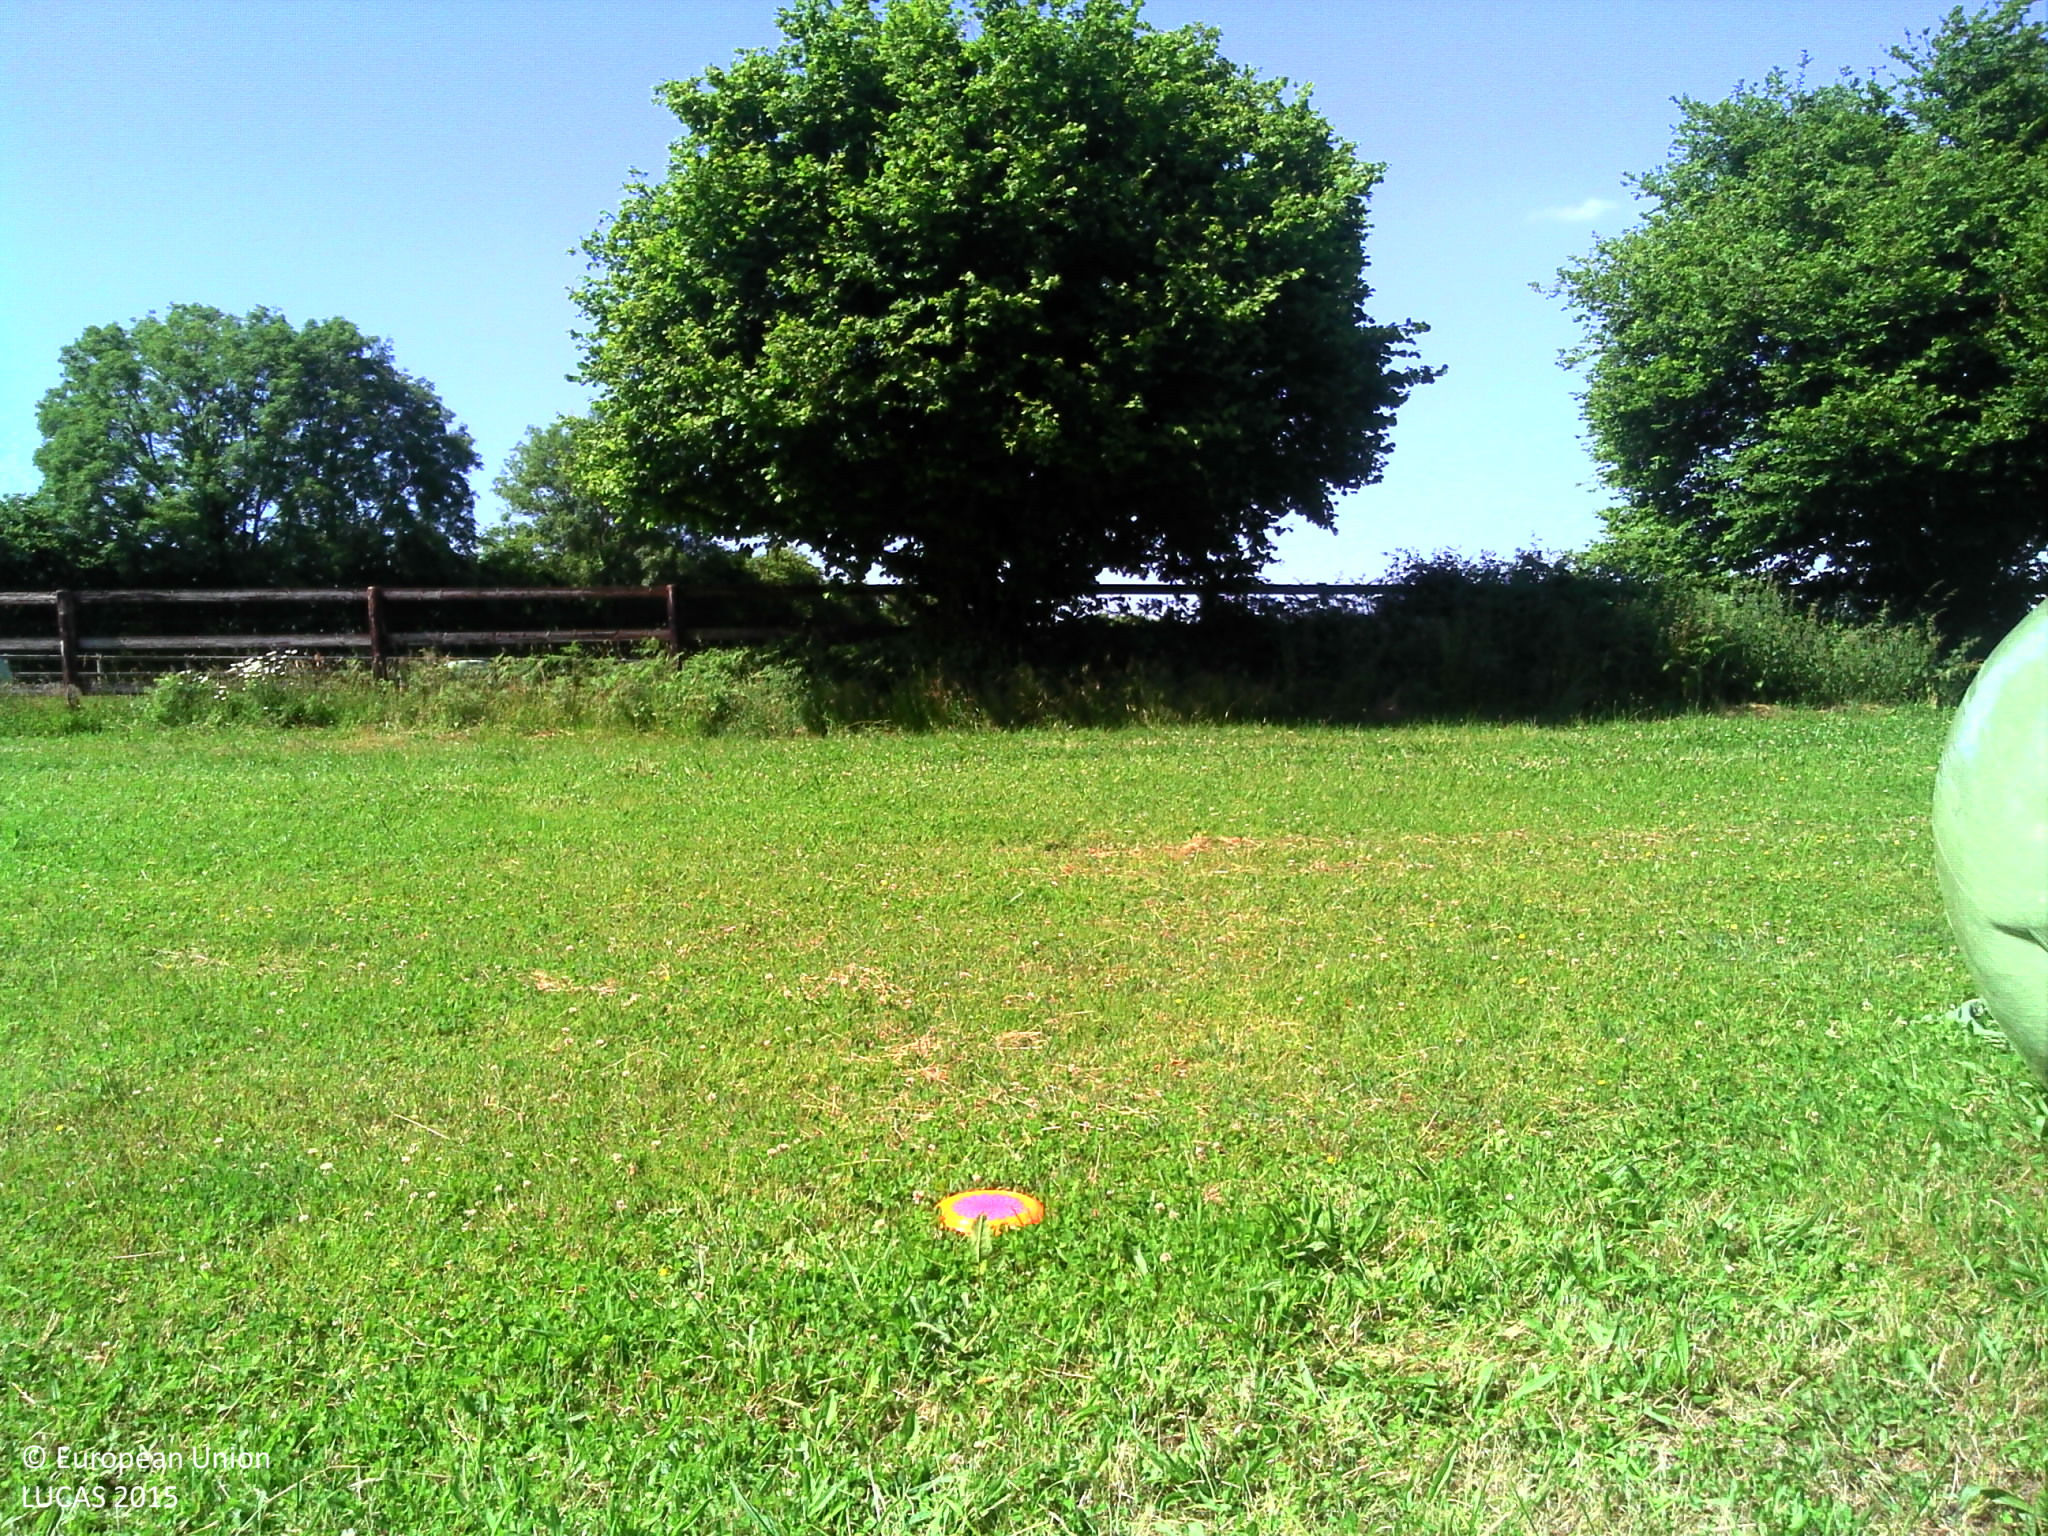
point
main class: Grassland
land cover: Grassland without tree/shrub cover
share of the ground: > 75 %
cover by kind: herbaceous plants 100 %
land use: Agriculture (excluding fallow land and kitchen gardens)
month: June
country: FR
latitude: 48.5558
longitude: 0.0943
